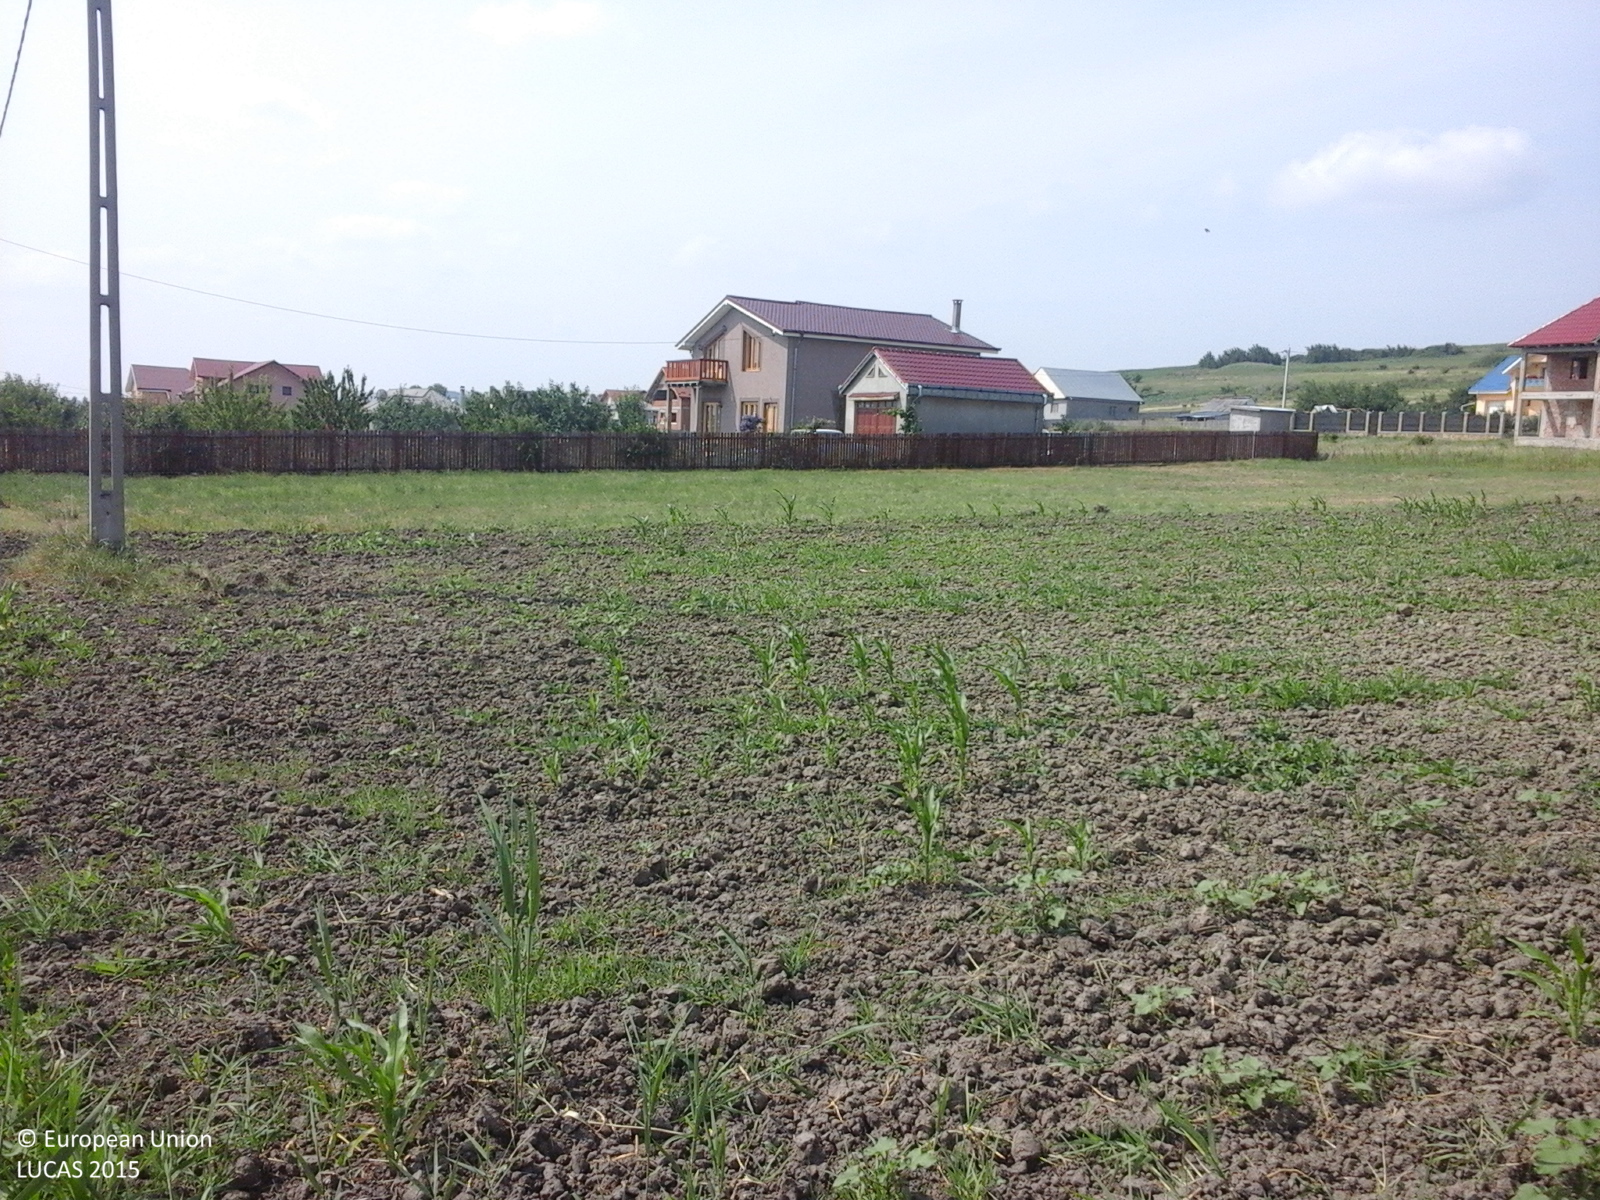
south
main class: Cropland
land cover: Maize
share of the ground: 10 - 25 %
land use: Agriculture (excluding fallow land and kitchen gardens)
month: June
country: RO
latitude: 47.3570
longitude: 26.9546
